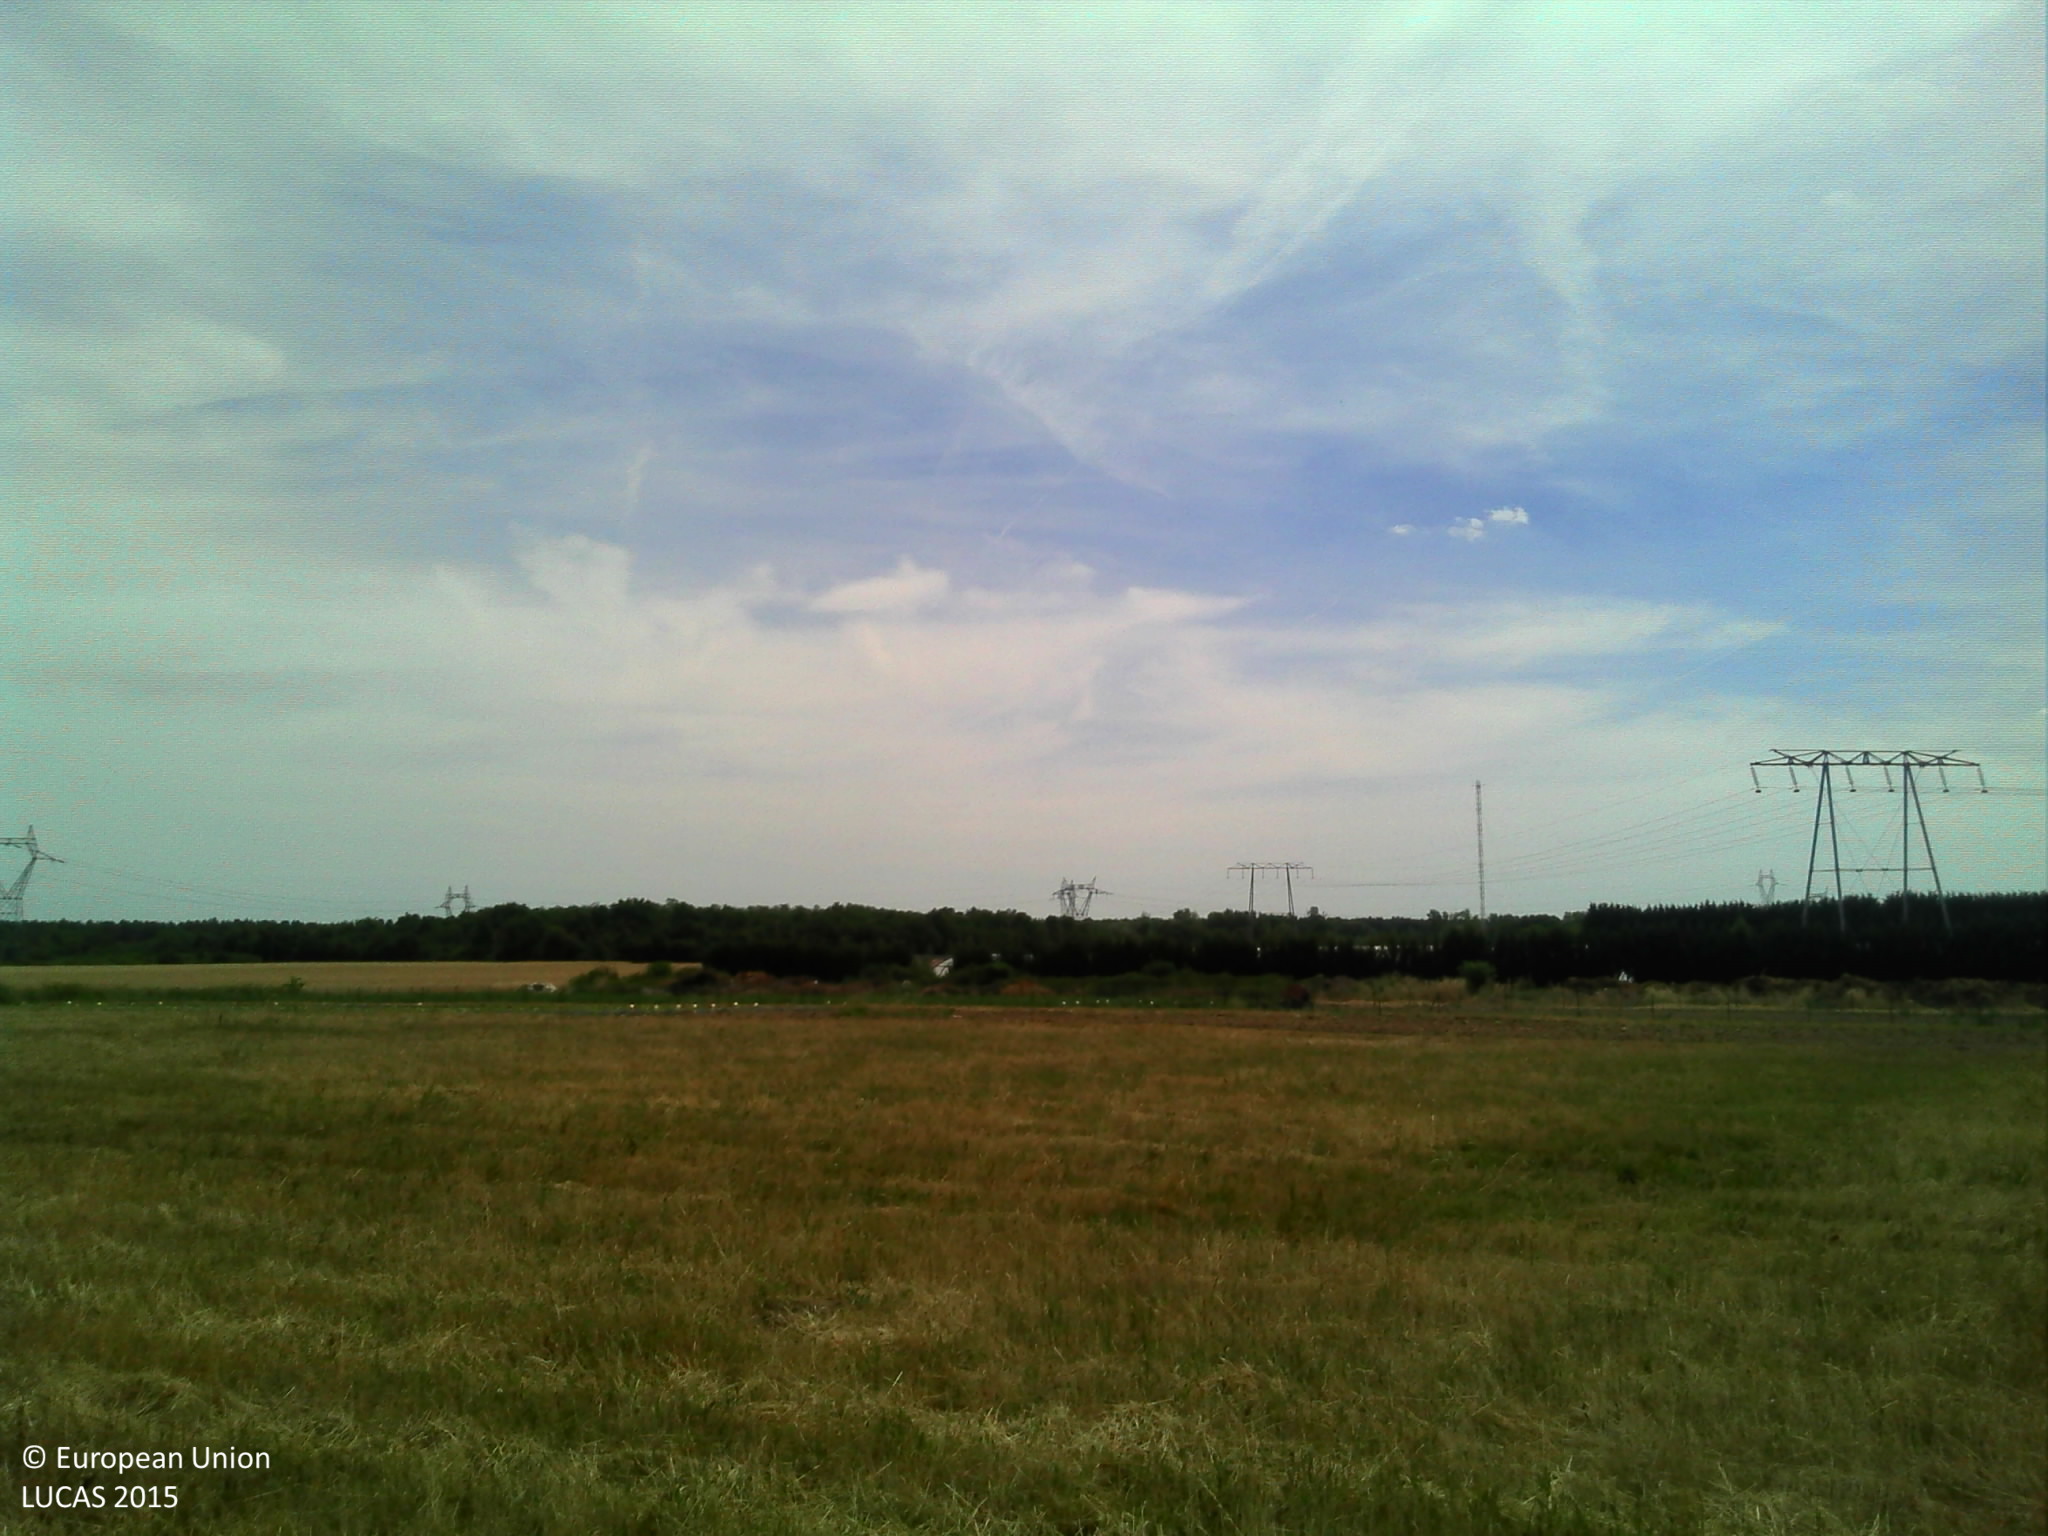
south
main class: Grassland
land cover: Grassland without tree/shrub cover
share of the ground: > 75 %
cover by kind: herbaceous plants 100 %
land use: Agriculture (excluding fallow land and kitchen gardens)
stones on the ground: < 10 %
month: June
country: FR
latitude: 47.7355
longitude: 2.5373
